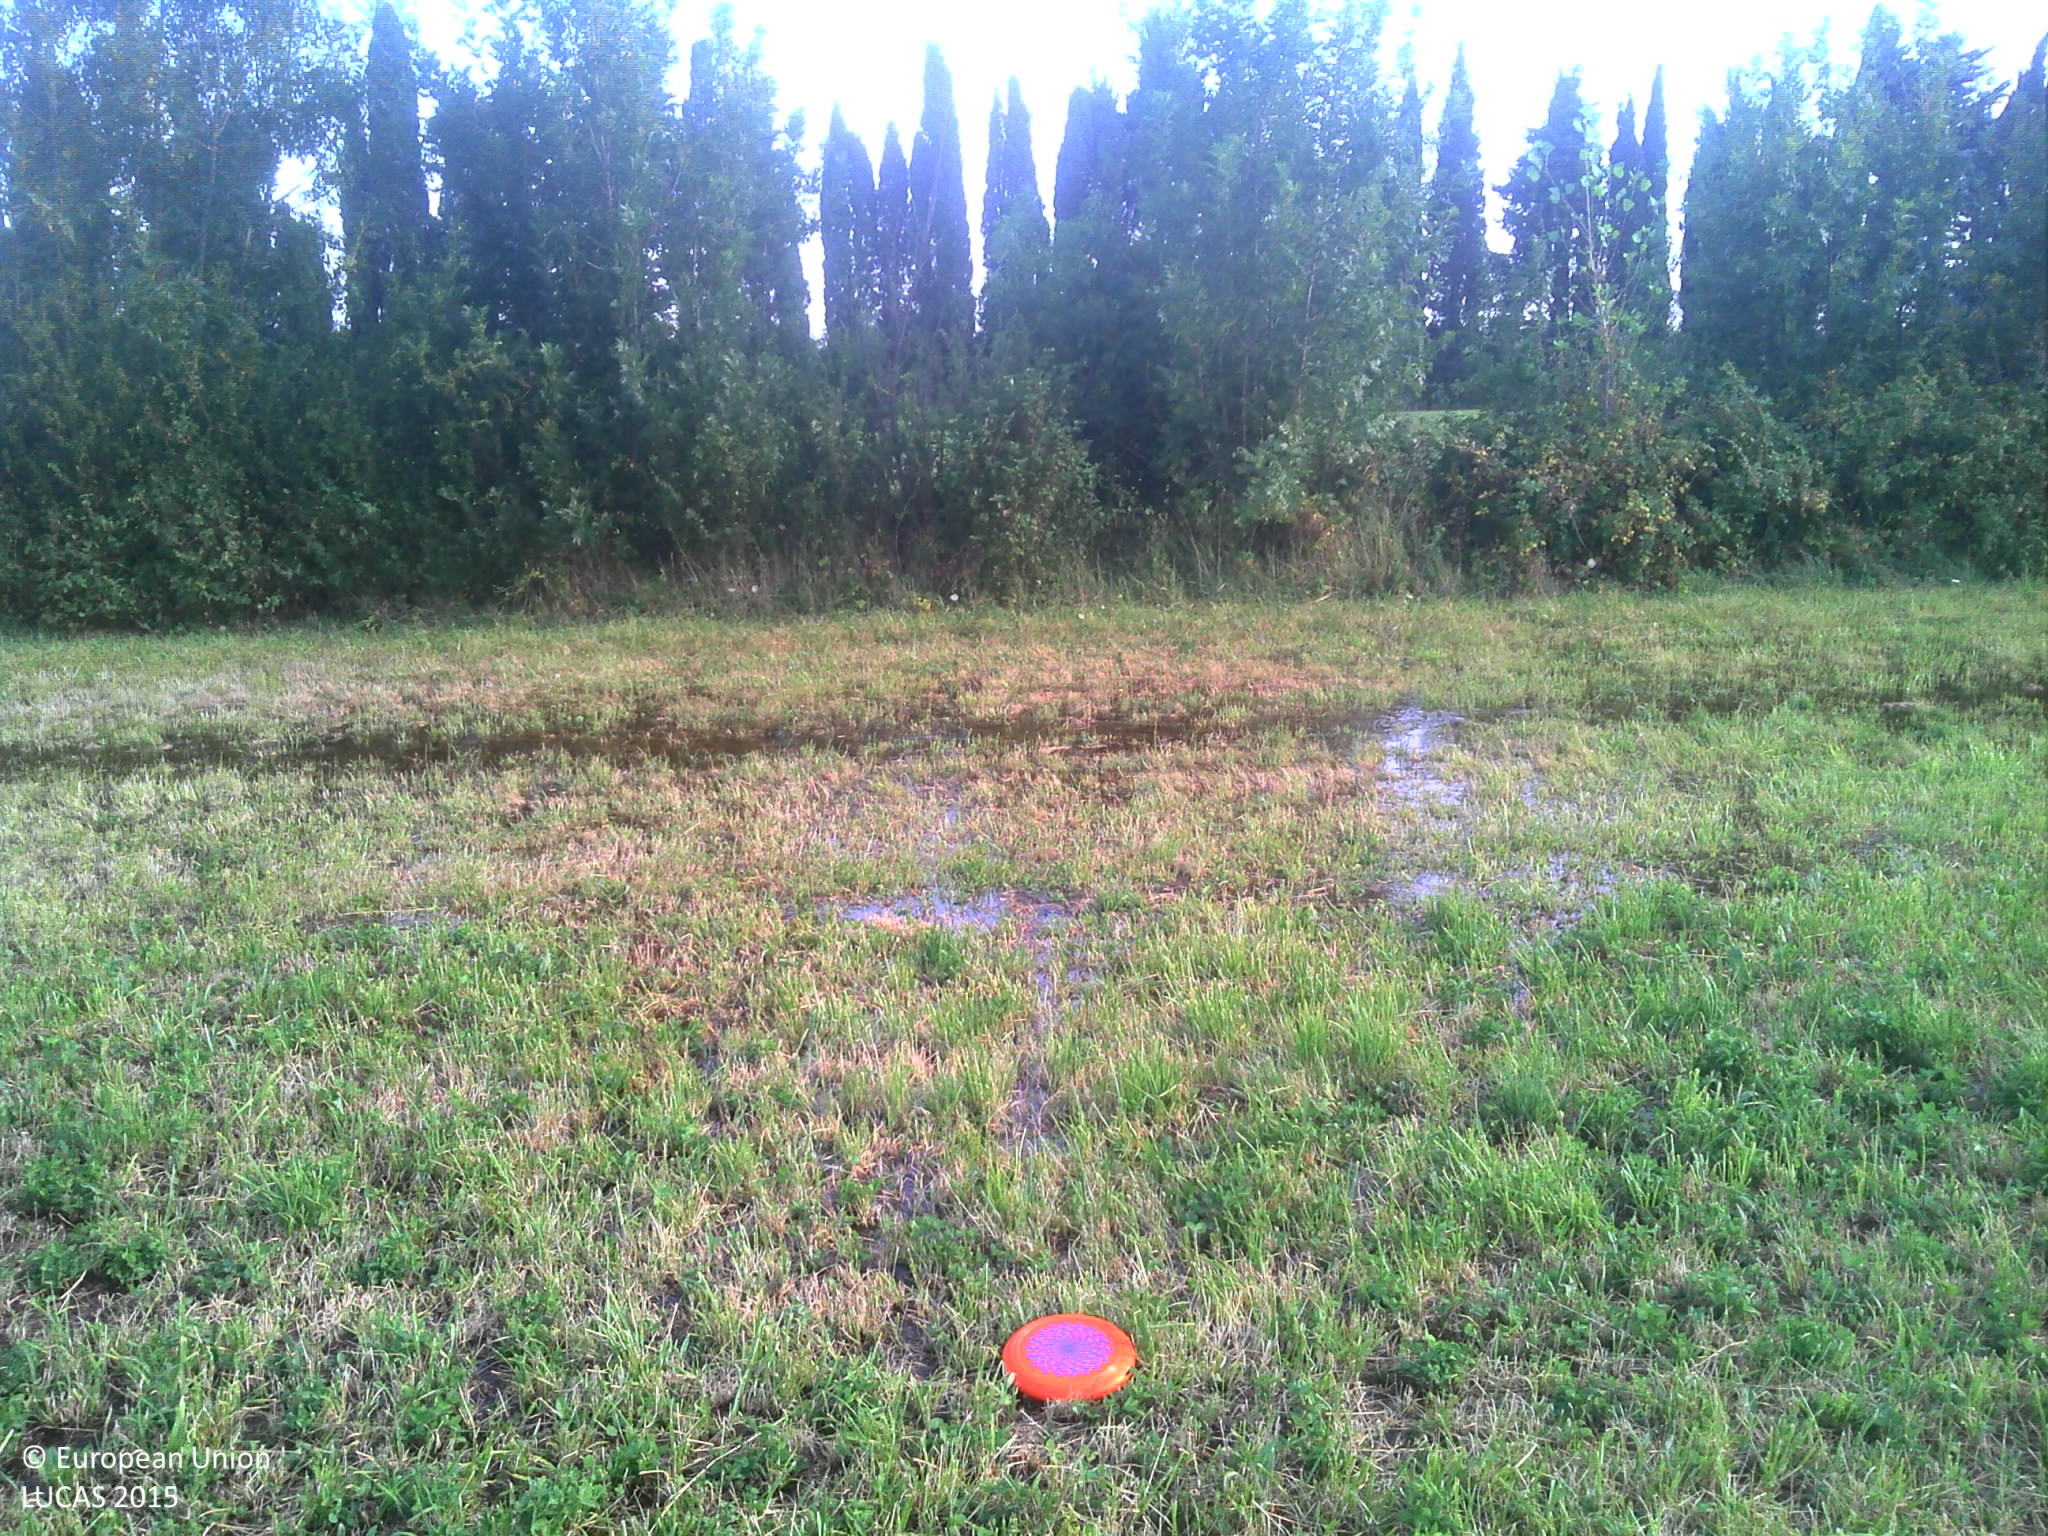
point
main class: Grassland
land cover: Grassland without tree/shrub cover
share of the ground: > 75 %
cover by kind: herbaceous plants 95 %, shrubs 5 %
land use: Agriculture (excluding fallow land and kitchen gardens)
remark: Temporary flooded
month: July
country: FR
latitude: 43.6919
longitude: 5.0838
